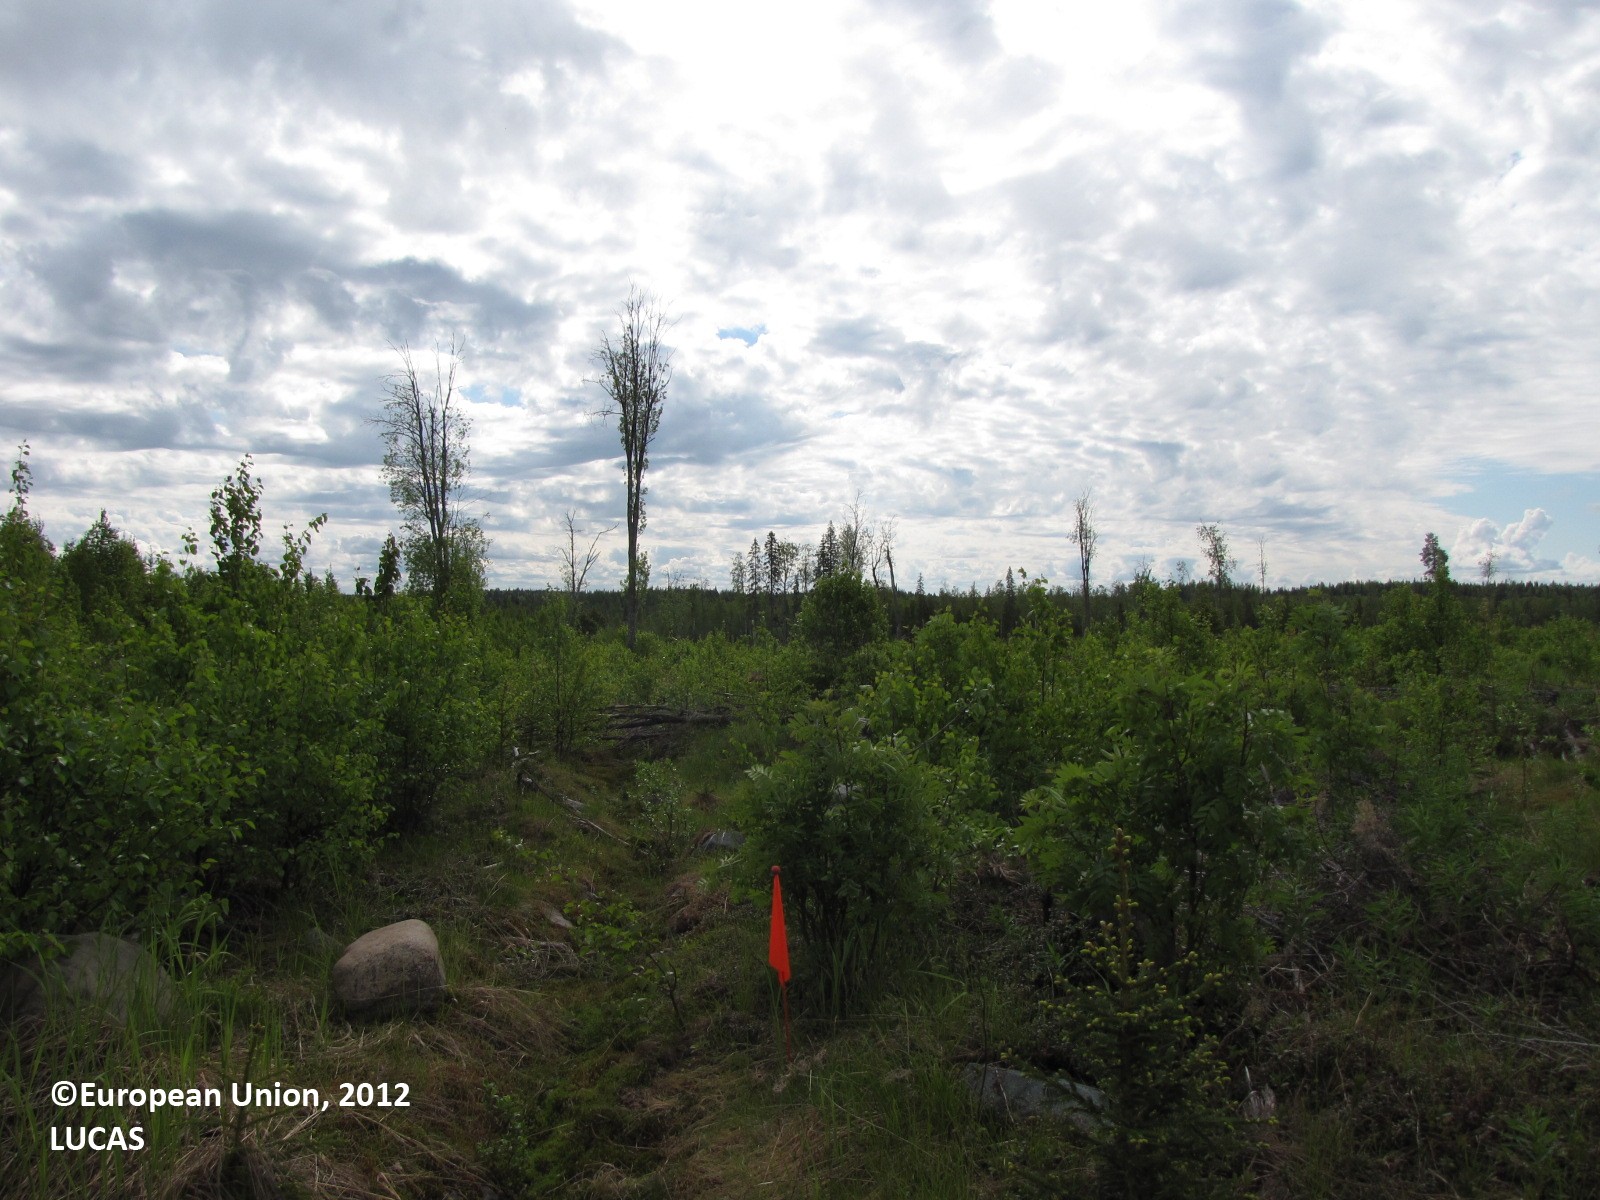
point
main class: Woodland
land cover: Broadleaved woodland
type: boreal forest
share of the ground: 25 - 50 %
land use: Forestry
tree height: < 5 m
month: June
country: FI
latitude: 66.0574
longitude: 24.6499
